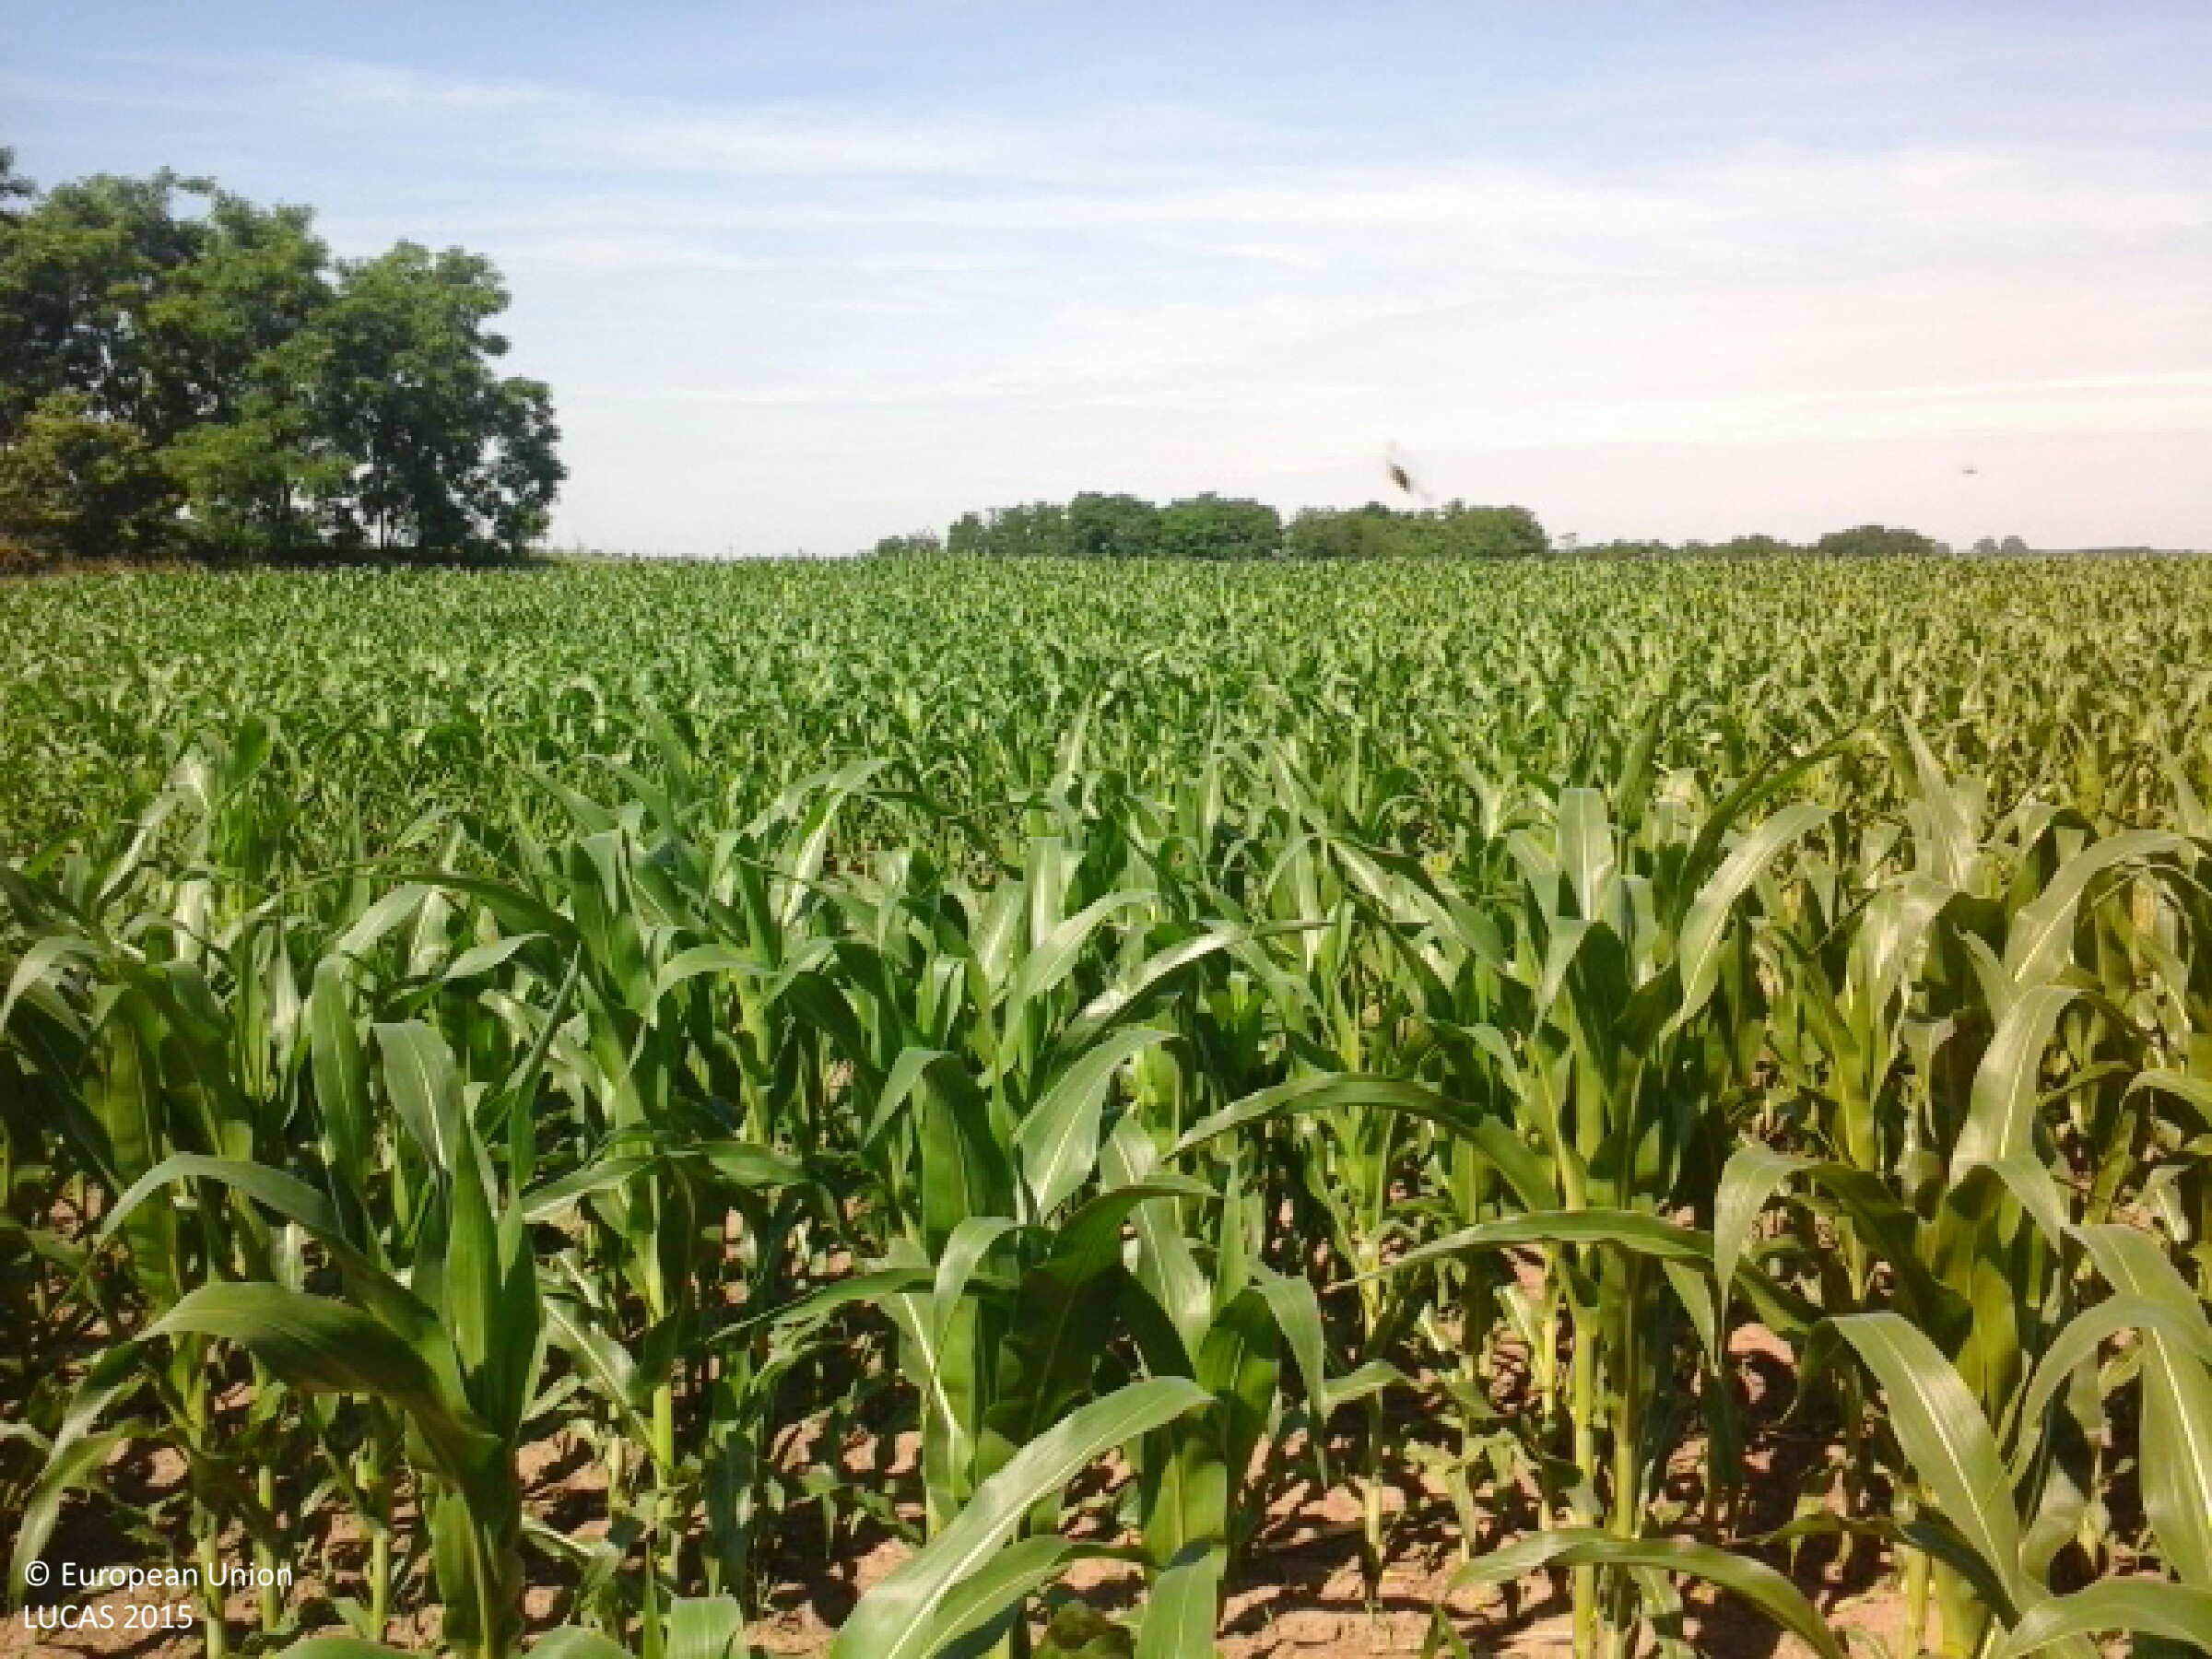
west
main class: Cropland
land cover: Maize
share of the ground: 50 - 75 %
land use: Agriculture (excluding fallow land and kitchen gardens)
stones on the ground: < 10 %
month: June
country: HU
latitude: 47.7950
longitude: 21.7285
